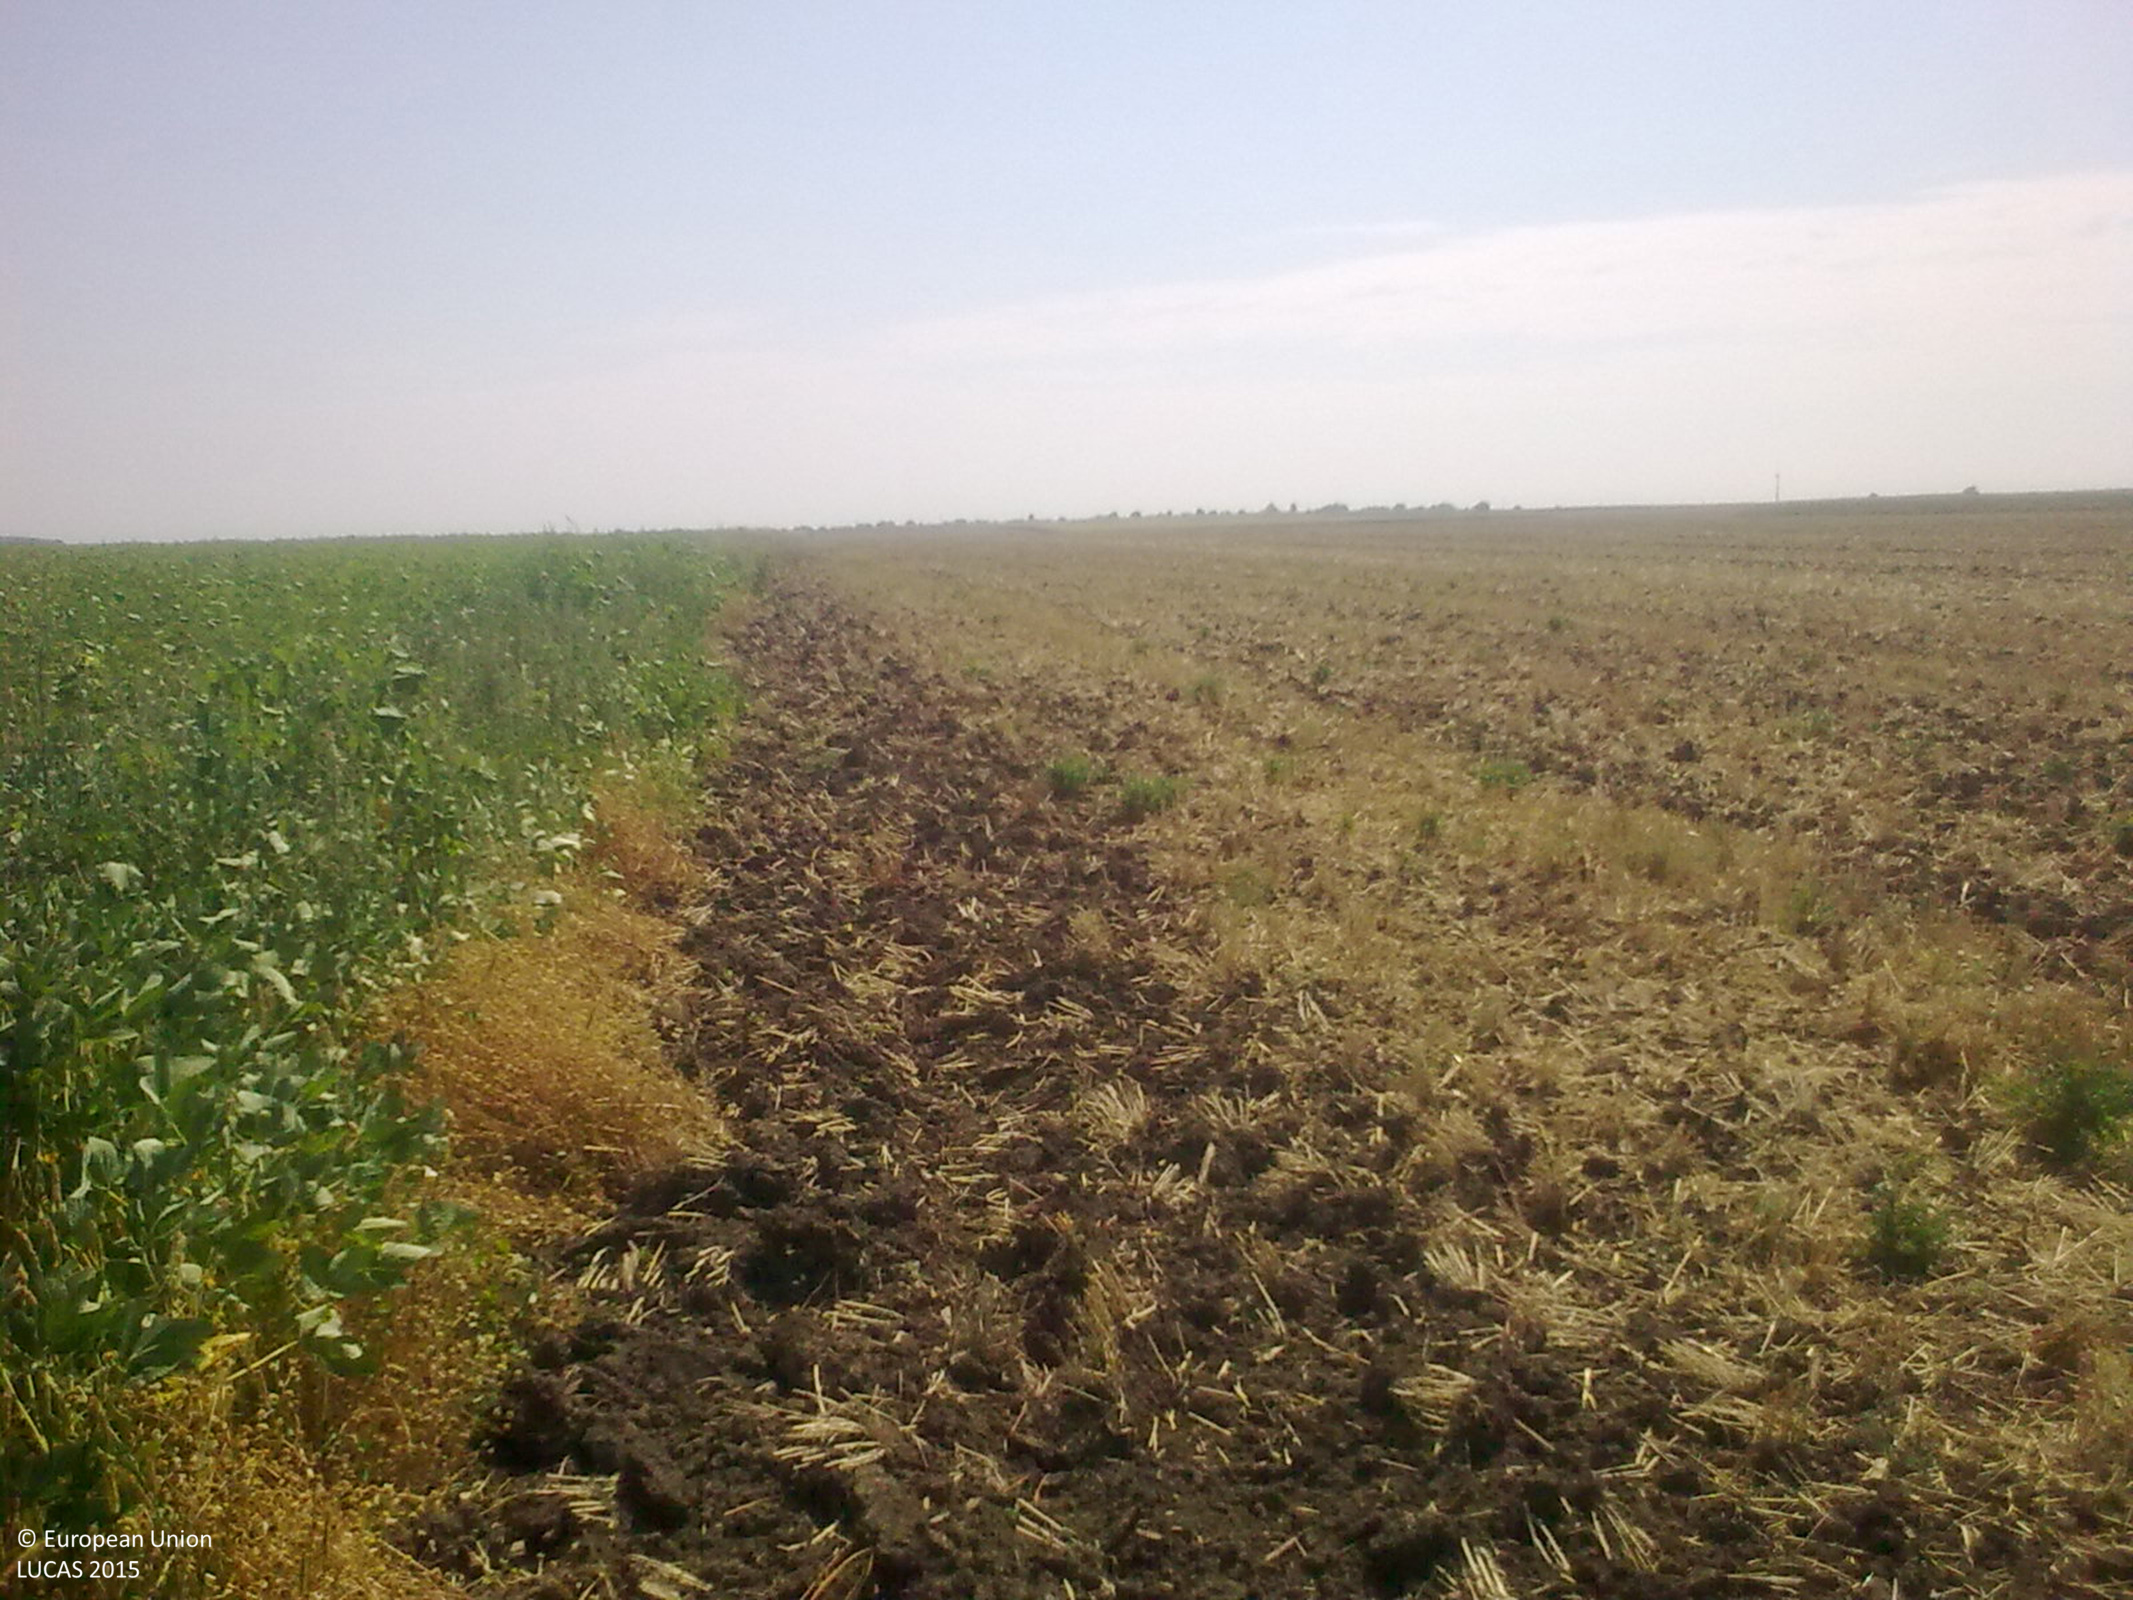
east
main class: Cropland
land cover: Soya
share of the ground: > 75 %
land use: Agriculture (excluding fallow land and kitchen gardens)
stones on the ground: < 10 %
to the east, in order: Soya
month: July
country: BG
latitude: 43.7733
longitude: 26.2652
